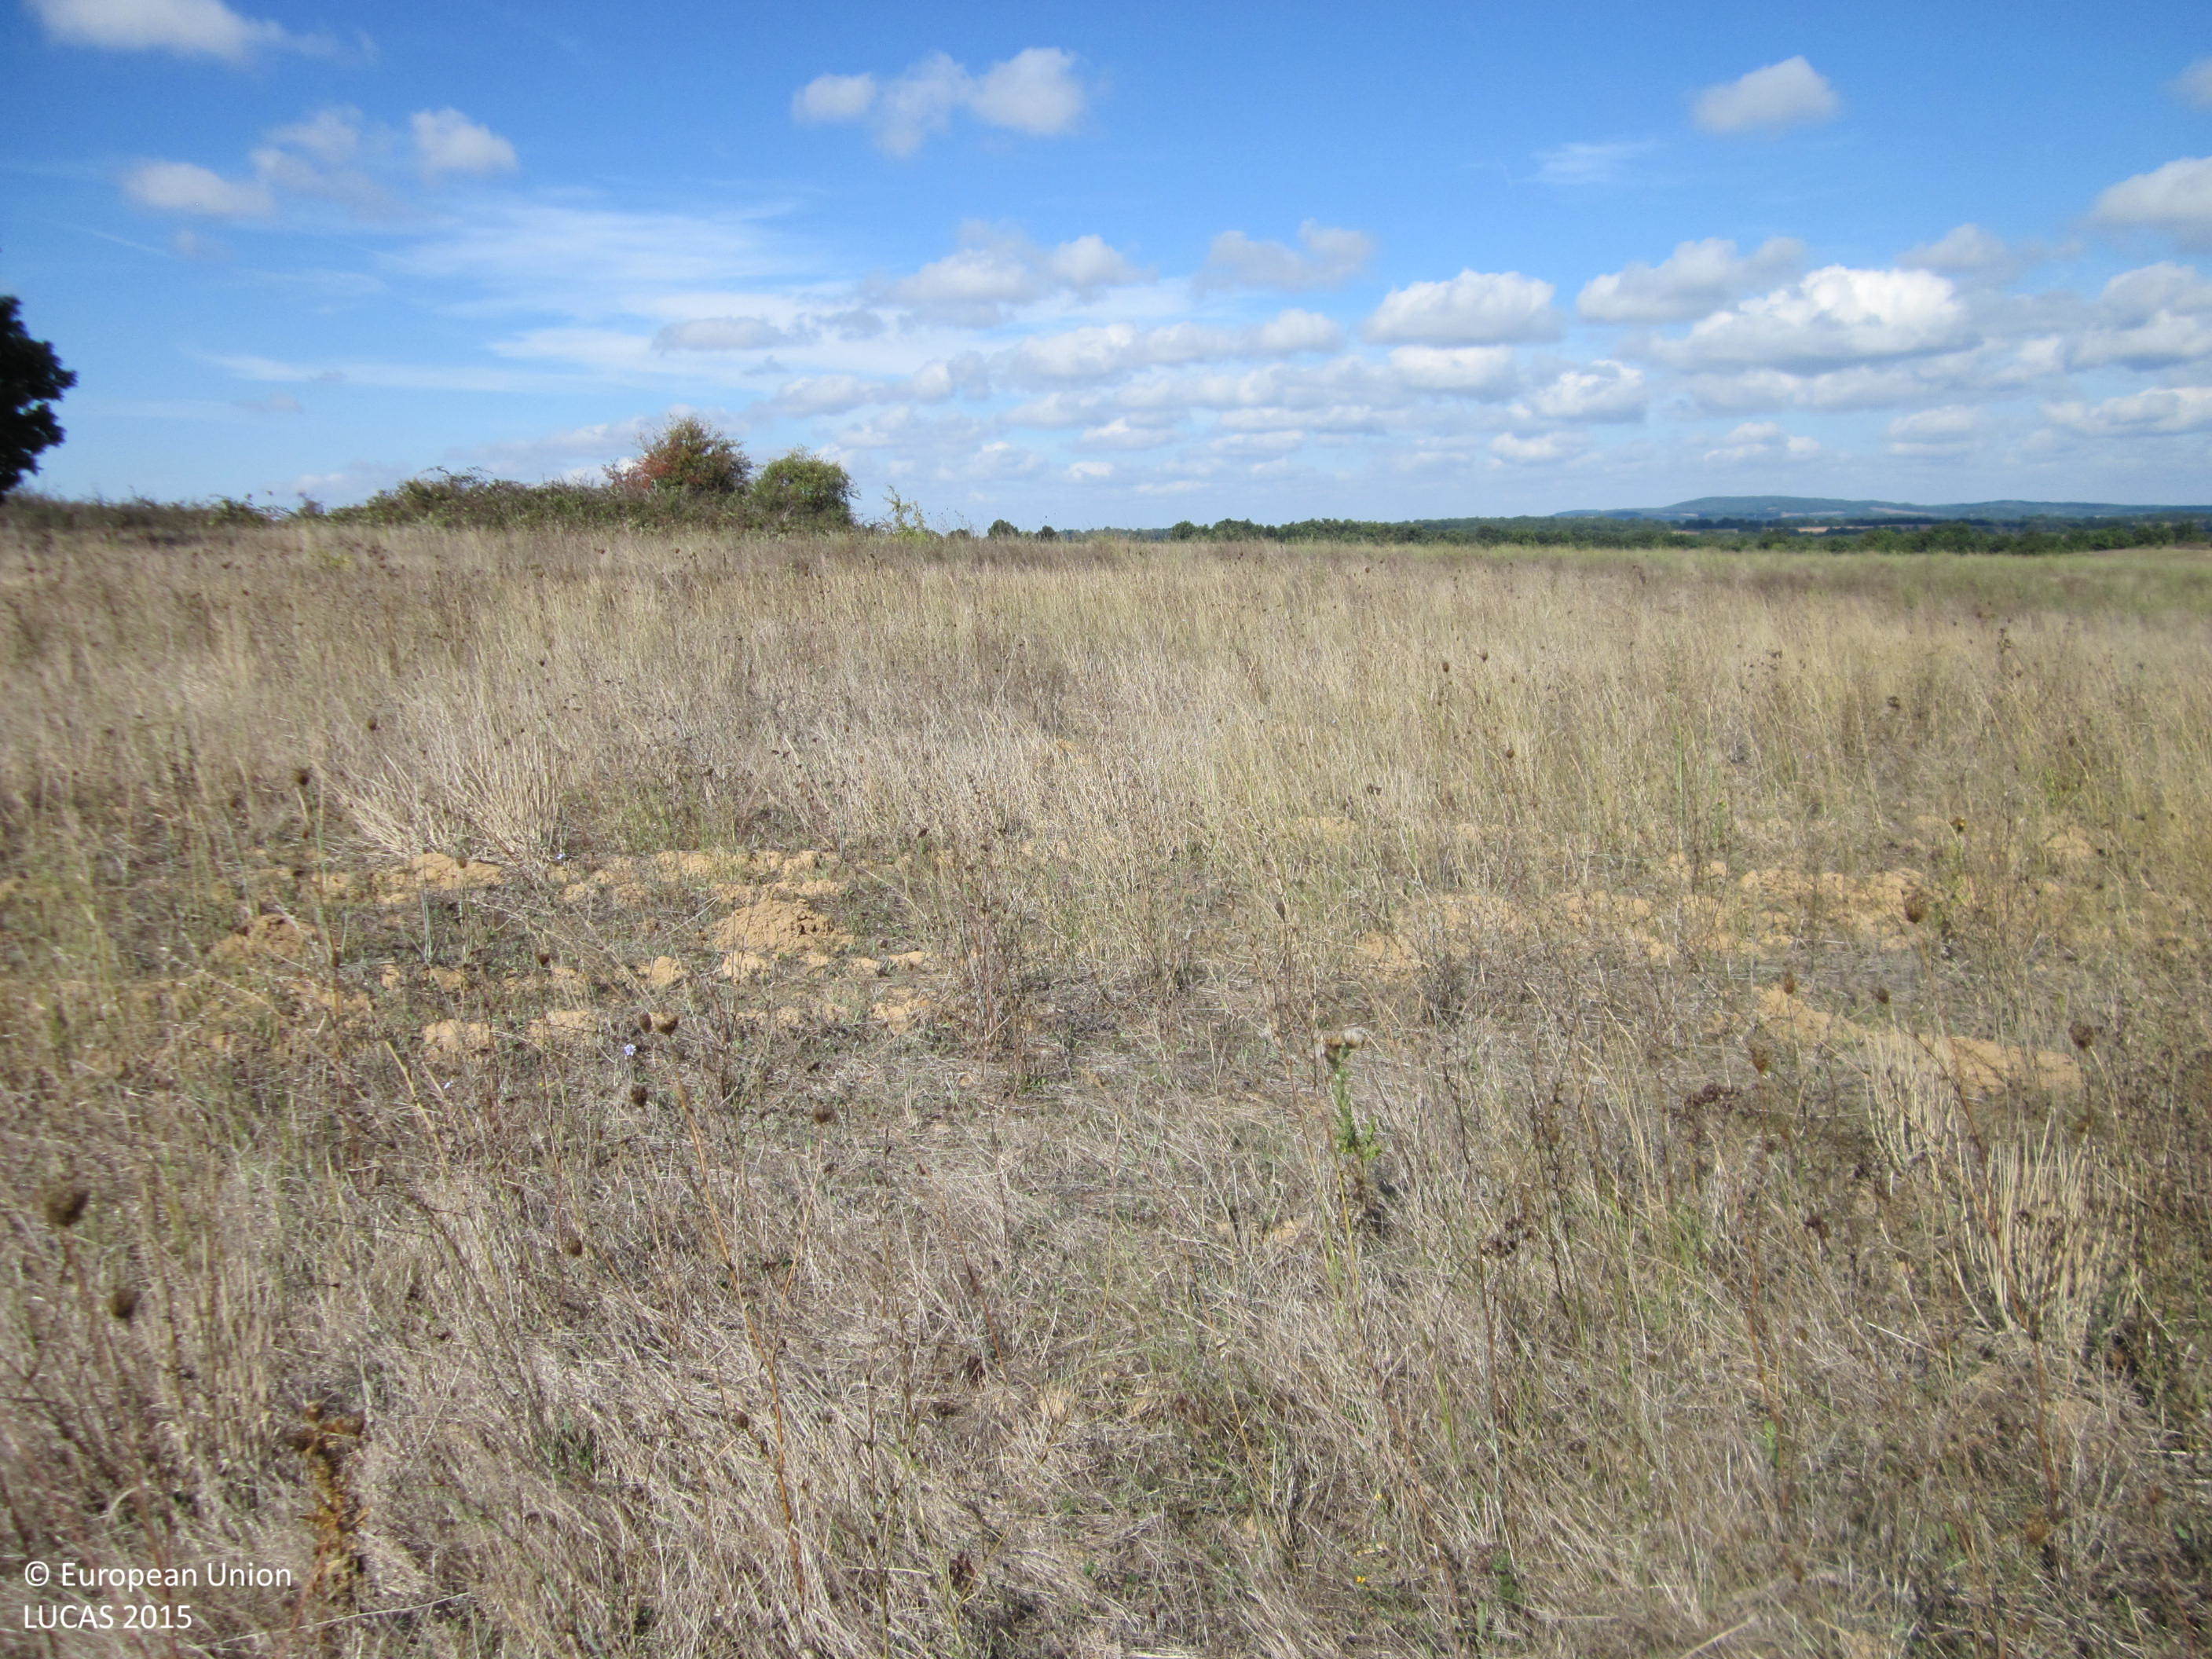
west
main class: Grassland
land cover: Spontaneously vegetated surfaces
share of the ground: > 75 %
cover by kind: herbaceous plants 95 %, unconsolidated bare surface 5 %
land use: Fallow land
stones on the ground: < 10 %
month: September
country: BG
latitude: 42.1444
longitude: 27.1032
